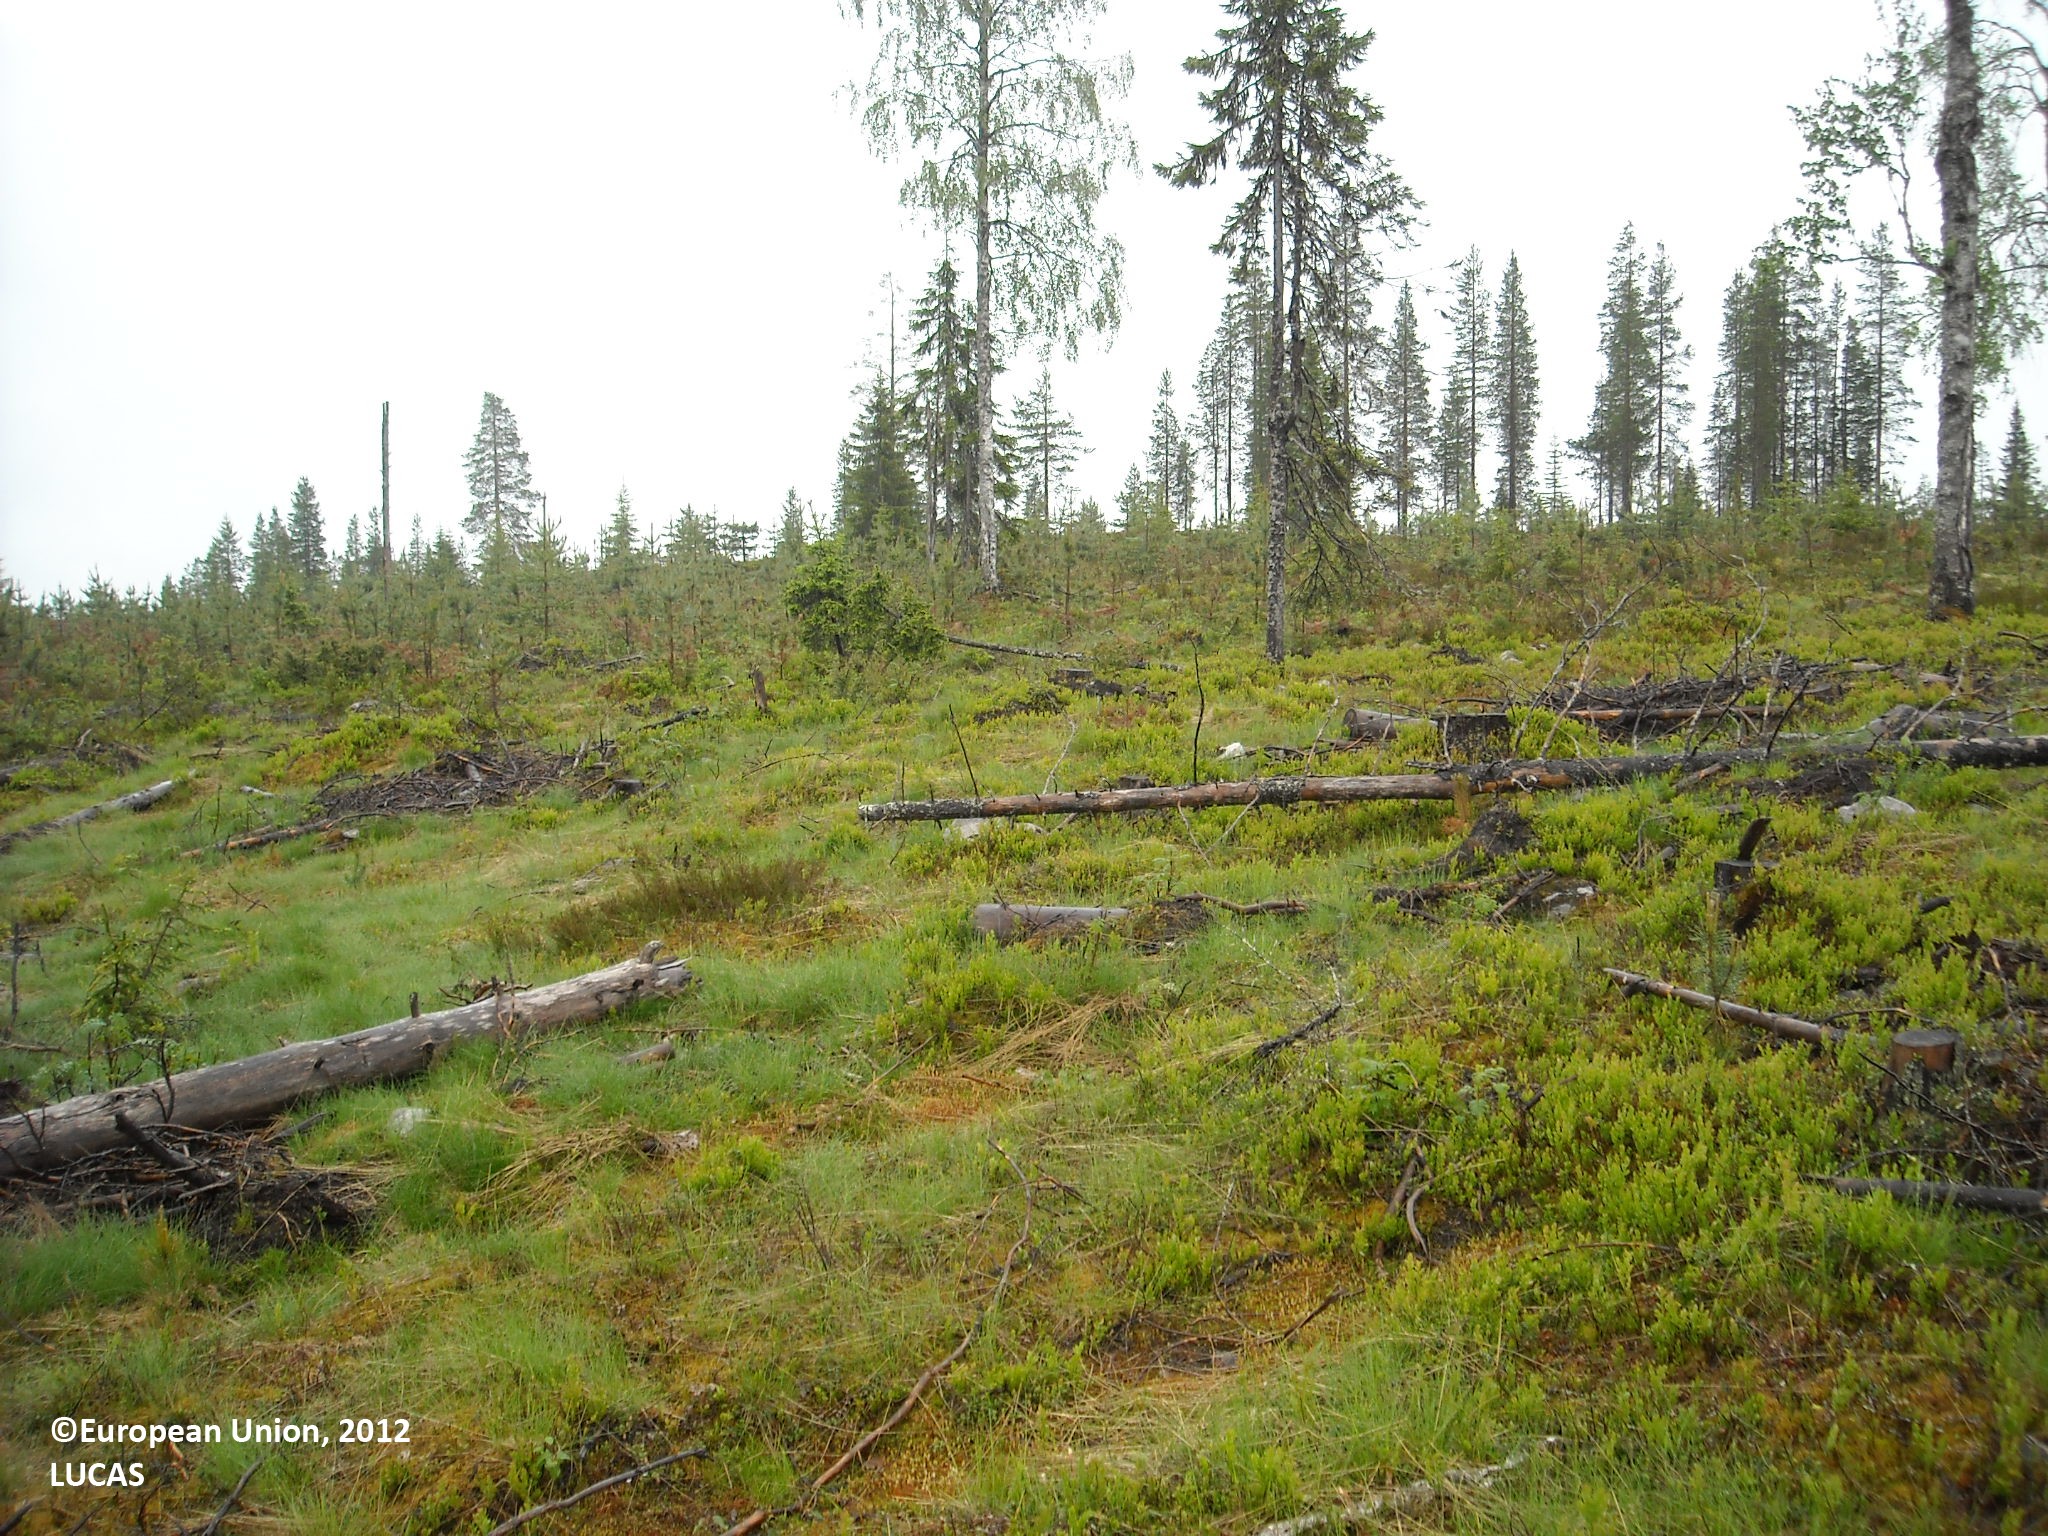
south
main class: Shrubland
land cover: Shrubland with sparse tree cover
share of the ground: > 75 %
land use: Forestry
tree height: > 5 m
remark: Clear cut
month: June
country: FI
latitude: 65.6035
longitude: 27.9105
